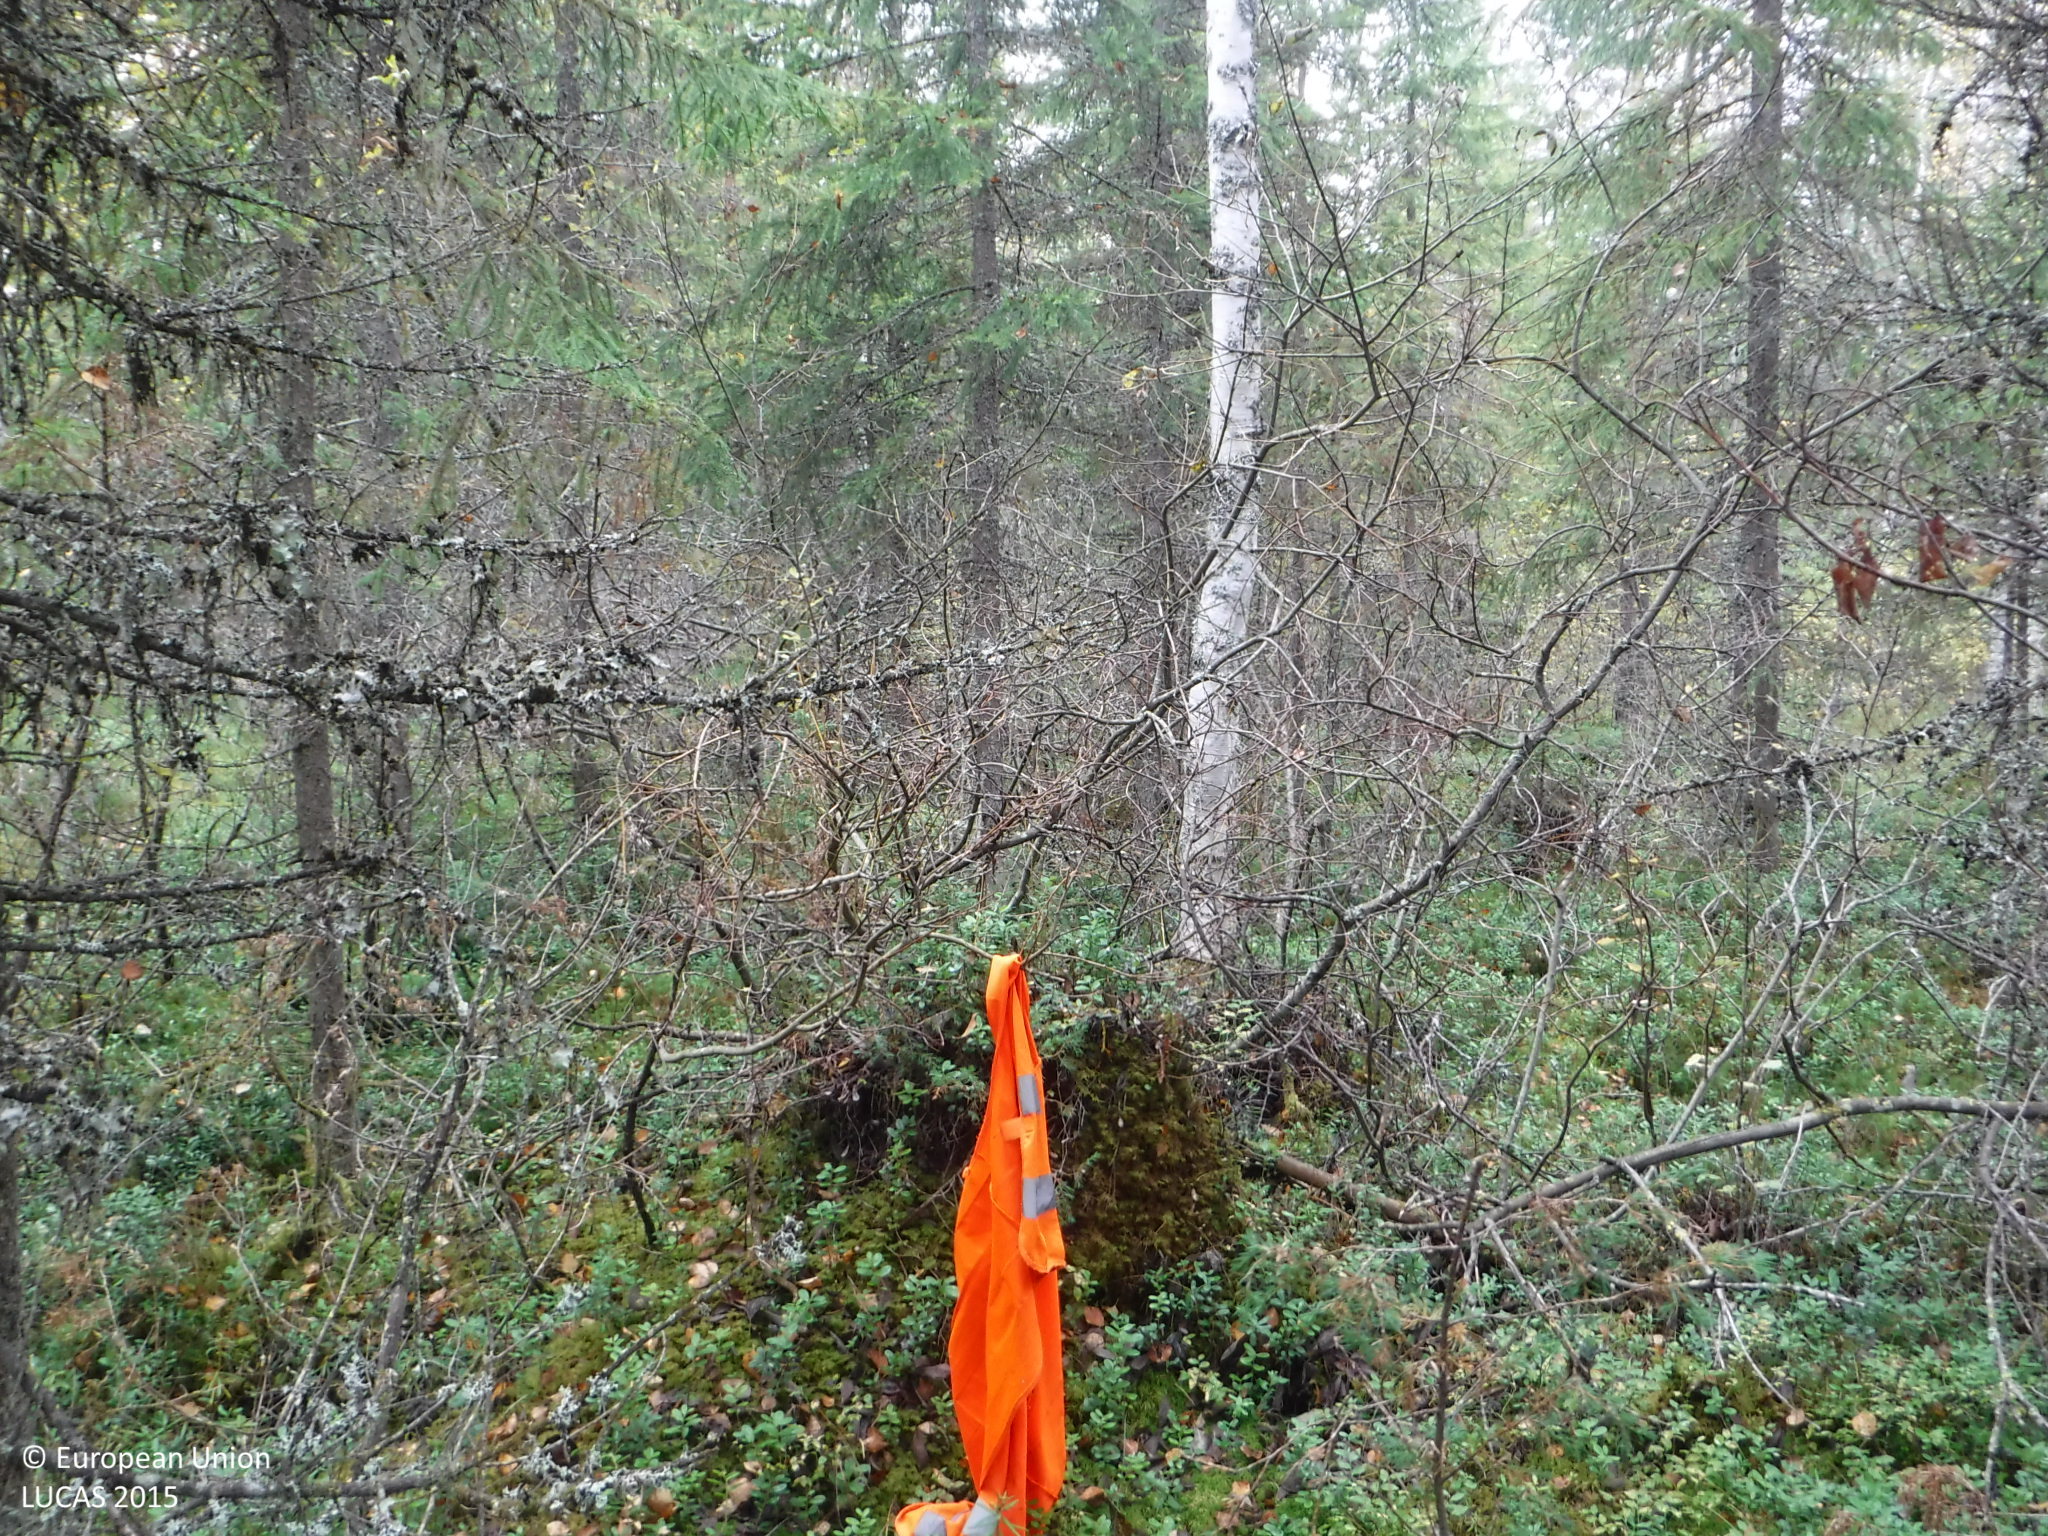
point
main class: Woodland
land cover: Other mixed woodland
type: boreal forest
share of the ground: 50 - 75 %
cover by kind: coniferous forest trees 30 %, shrubs 30 %, broadleaved forest trees 25 %, lichens and mosses 15 %
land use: Forestry
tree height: > 5 m
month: September
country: FI
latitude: 62.0708
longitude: 23.3347
